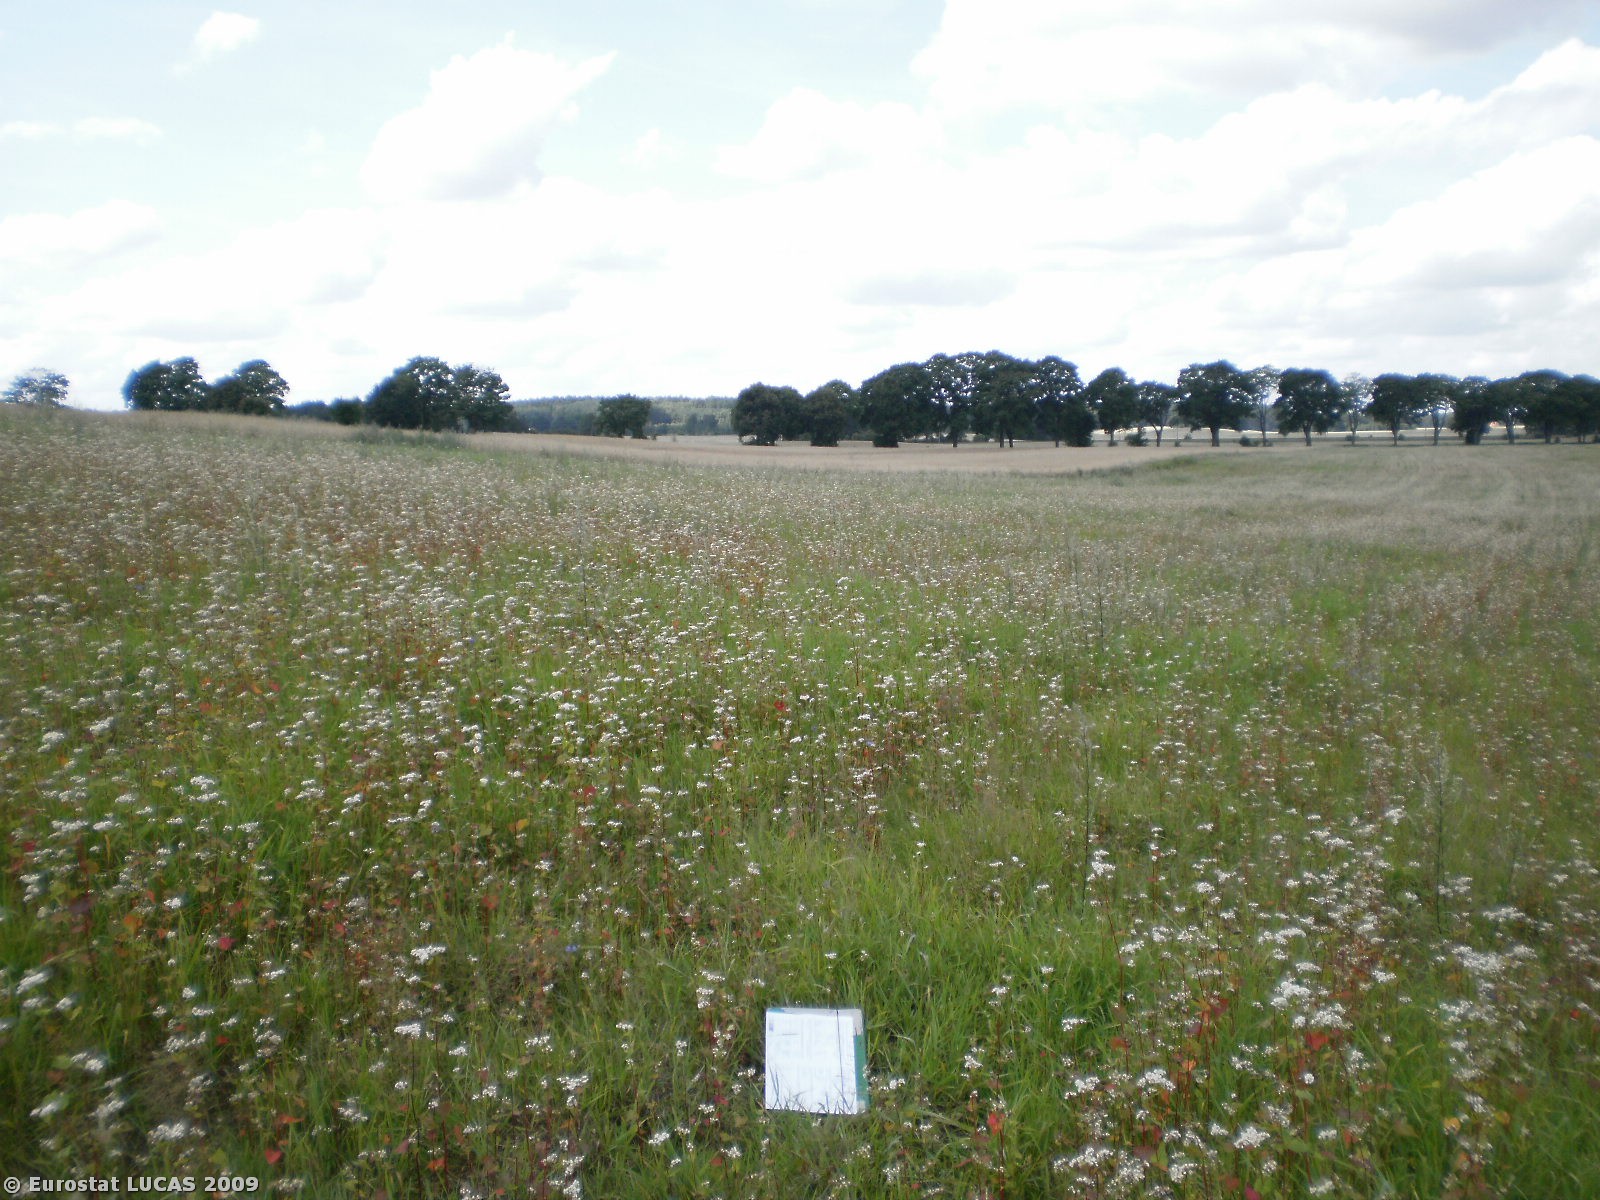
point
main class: Cropland
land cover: Other cereals
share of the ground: > 75 %
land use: Agriculture (excluding fallow land and kitchen gardens)
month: July
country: PL
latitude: 53.4239
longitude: 20.4047
